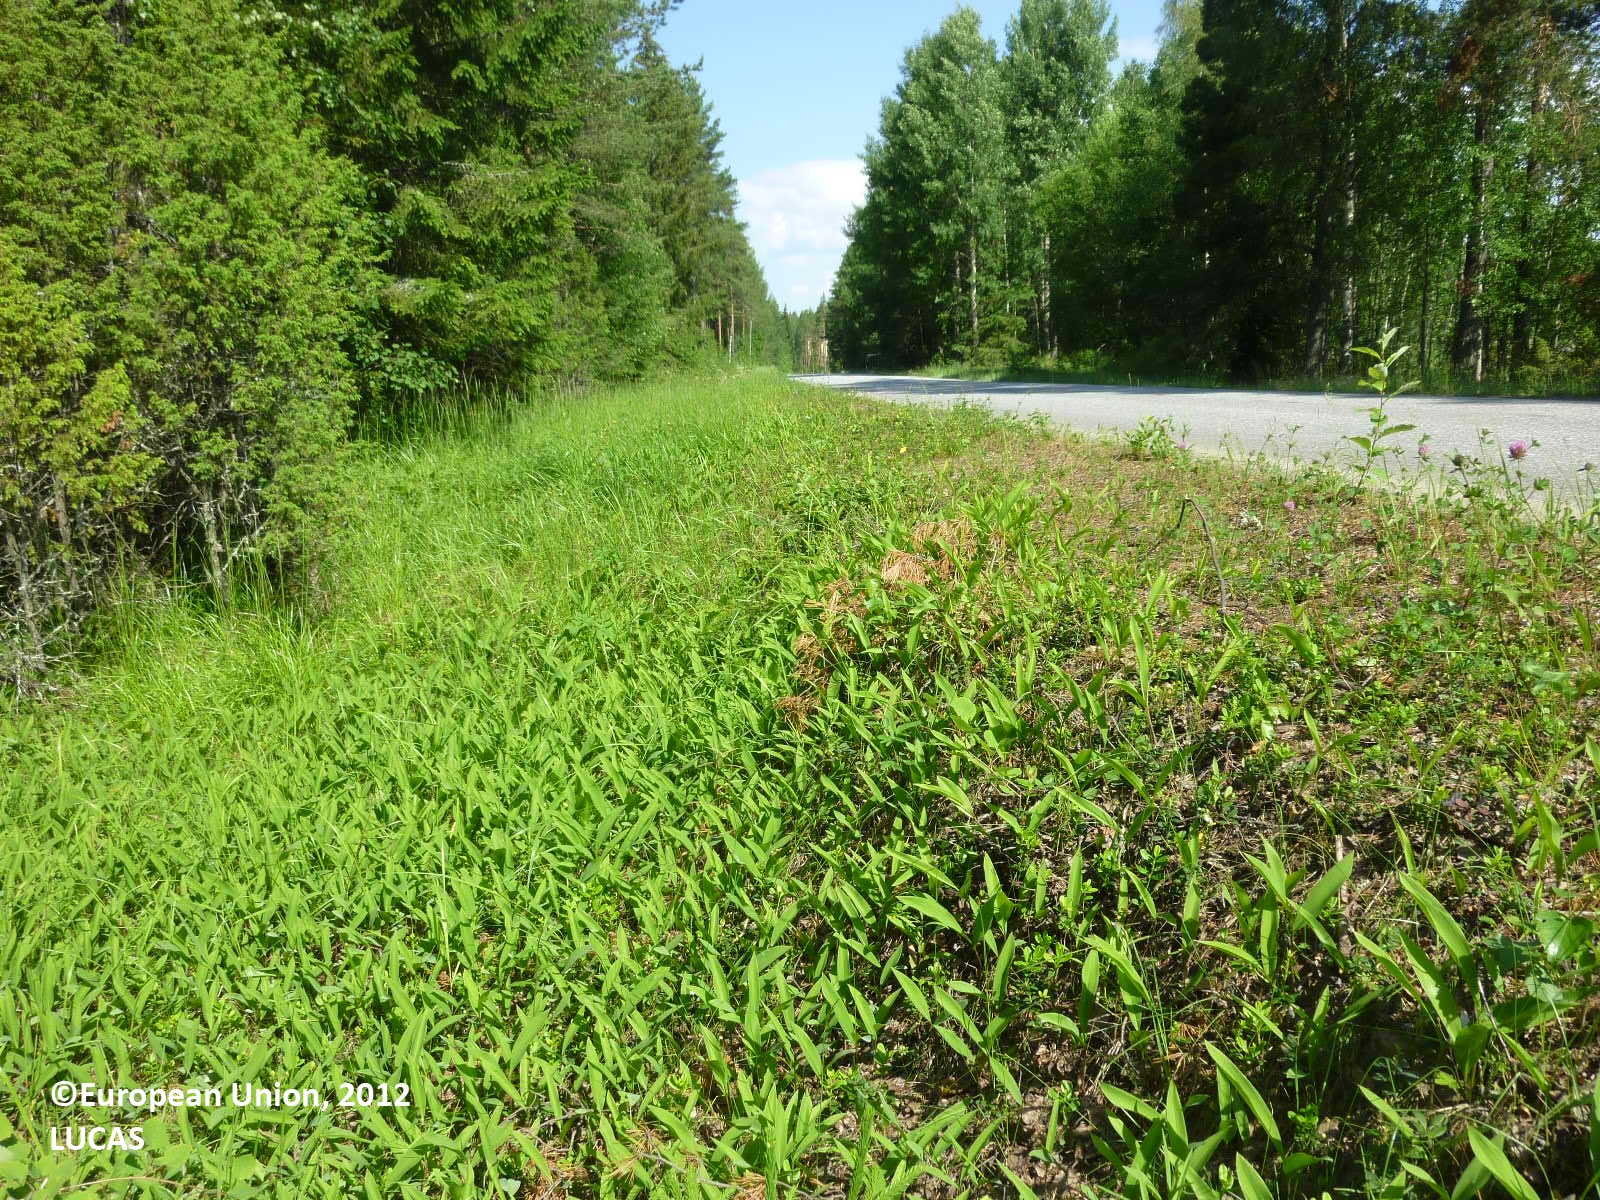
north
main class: Grassland
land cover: Grassland without tree/shrub cover
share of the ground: > 75 %
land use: Road transport
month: July
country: FI
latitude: 61.2545
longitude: 22.4225
